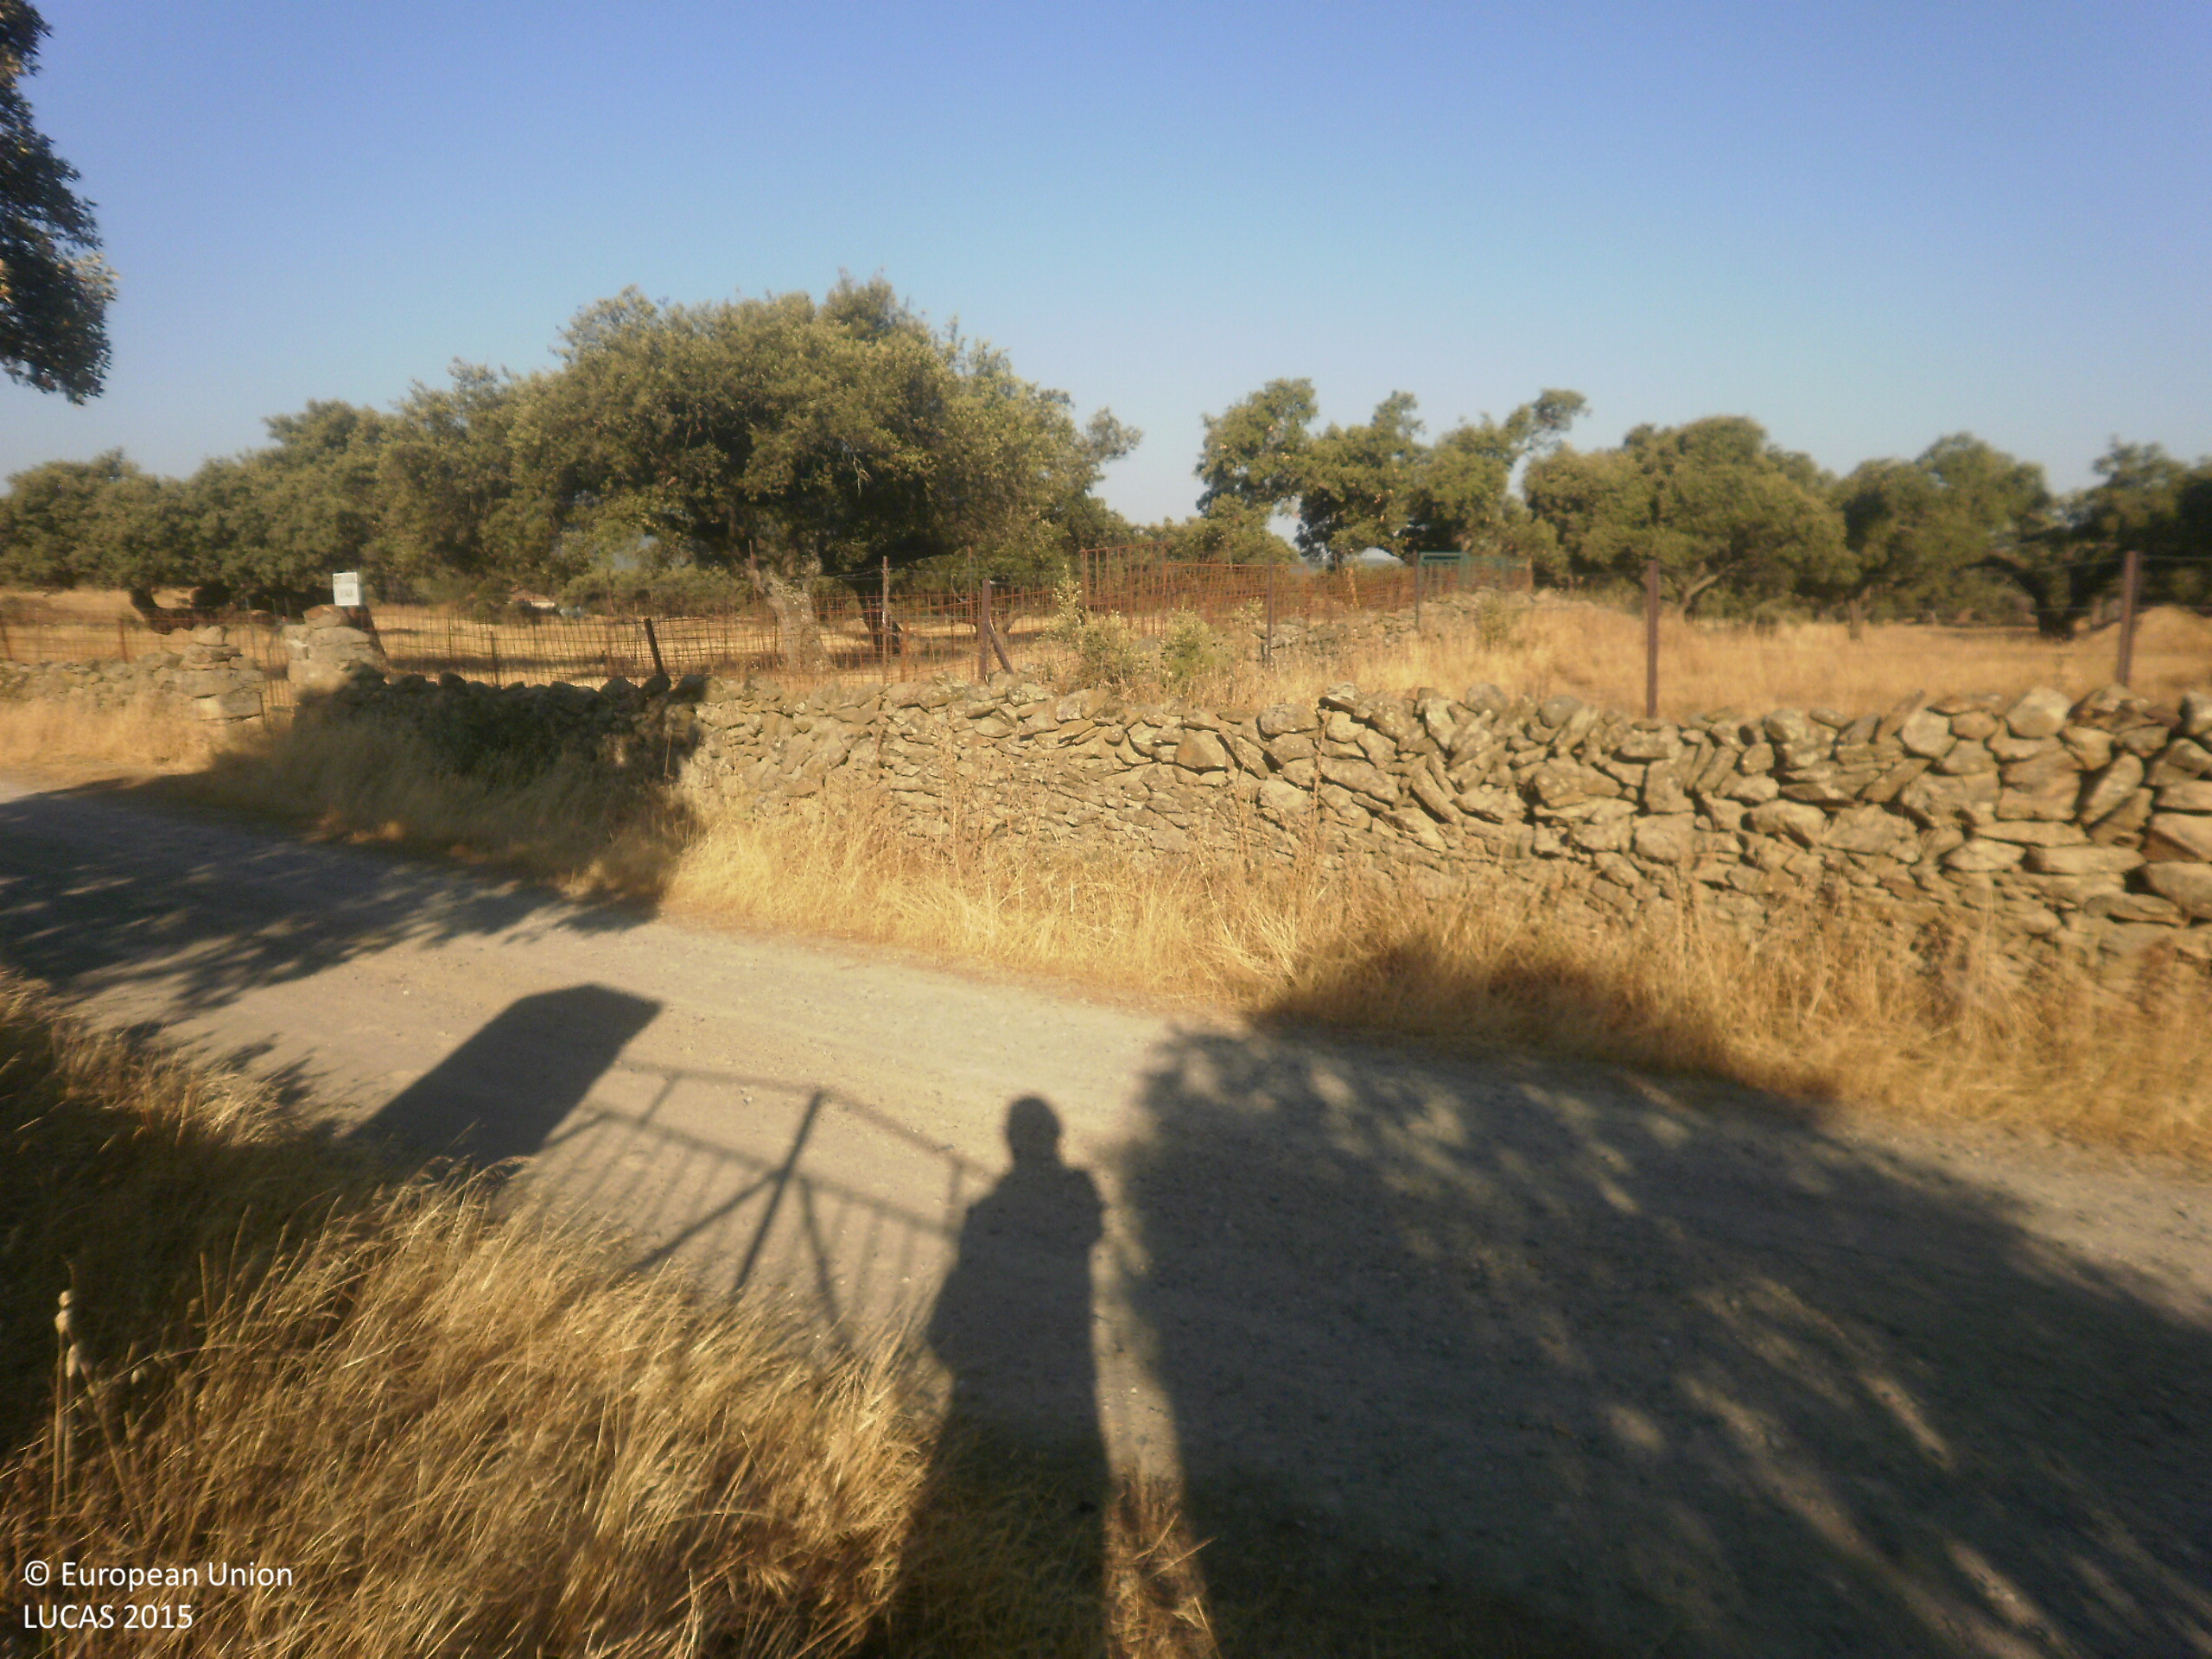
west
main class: Woodland
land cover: Broadleaved woodland
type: broadleaved evergreen forest
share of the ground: 50 - 75 %
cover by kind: broadleaved forest trees 100 %
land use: Agriculture (excluding fallow land and kitchen gardens)
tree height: > 5 m
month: June
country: ES
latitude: 39.2728
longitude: -6.0189
